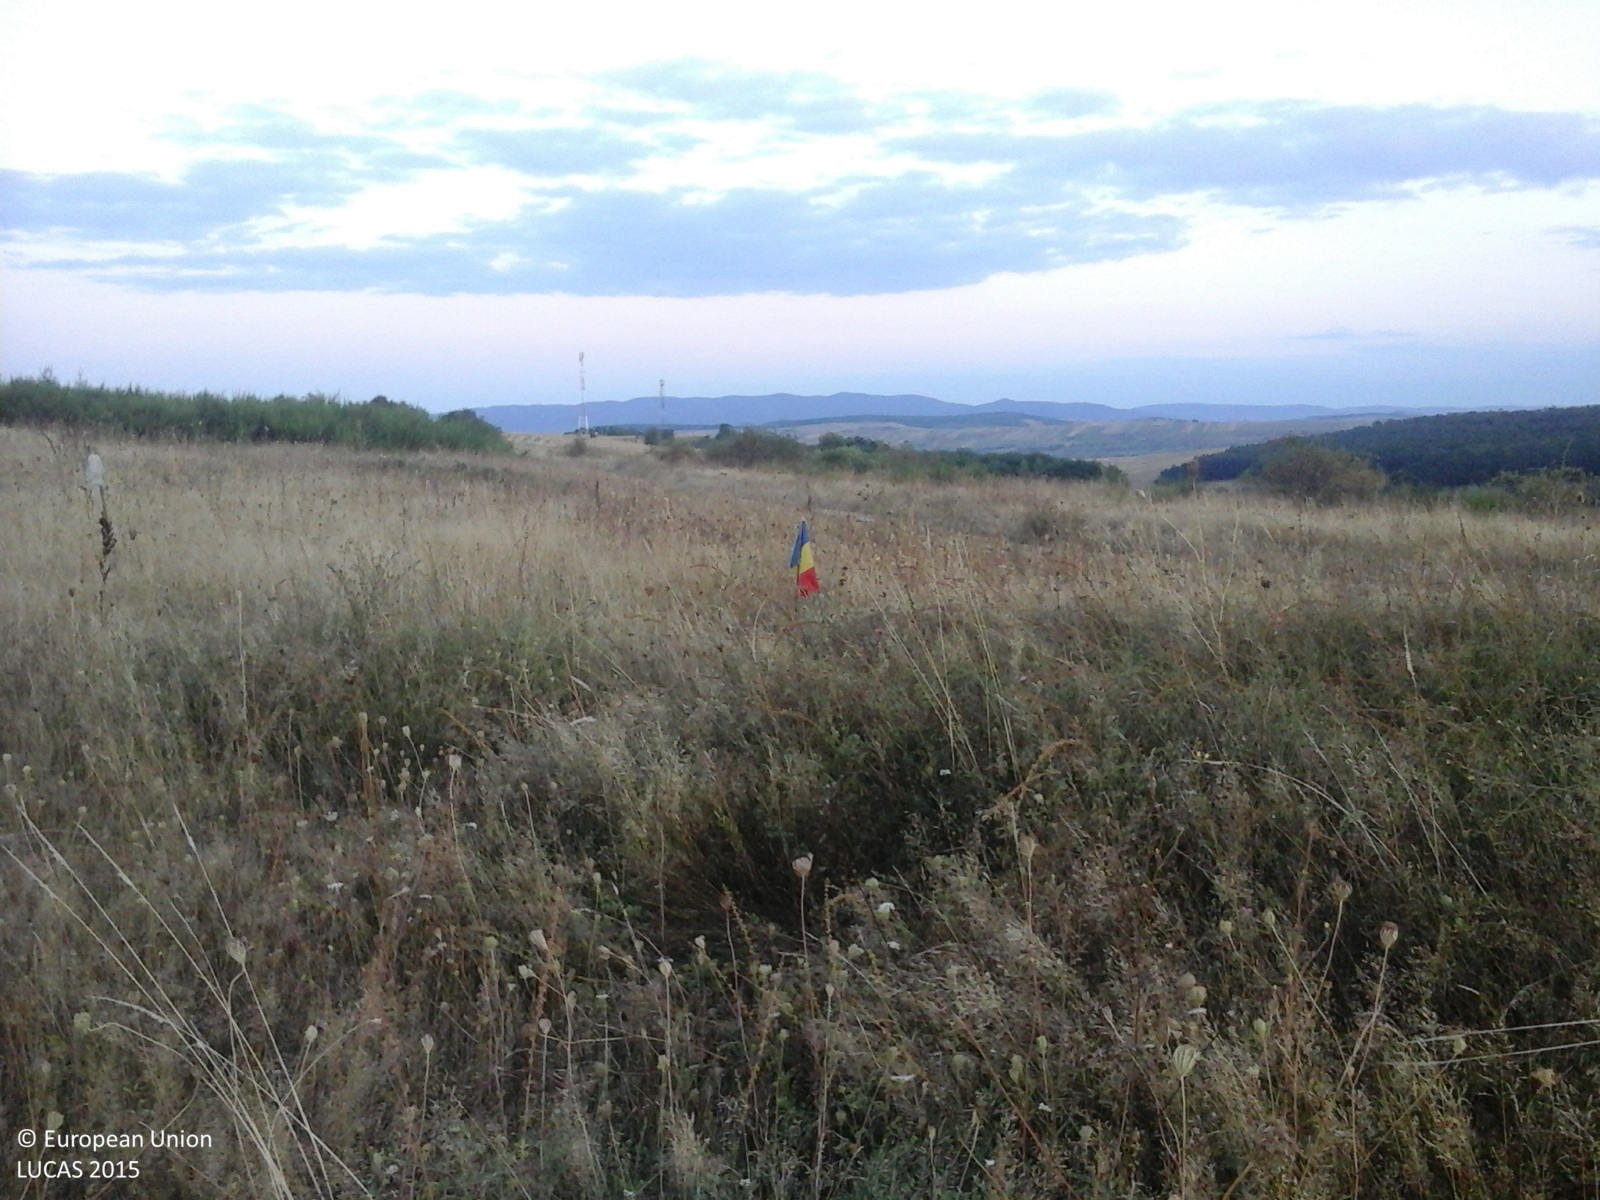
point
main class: Grassland
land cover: Spontaneously vegetated surfaces
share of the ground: > 75 %
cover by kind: herbaceous plants 100 %
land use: Fallow land
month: September
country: RO
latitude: 47.5020
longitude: 23.1711
